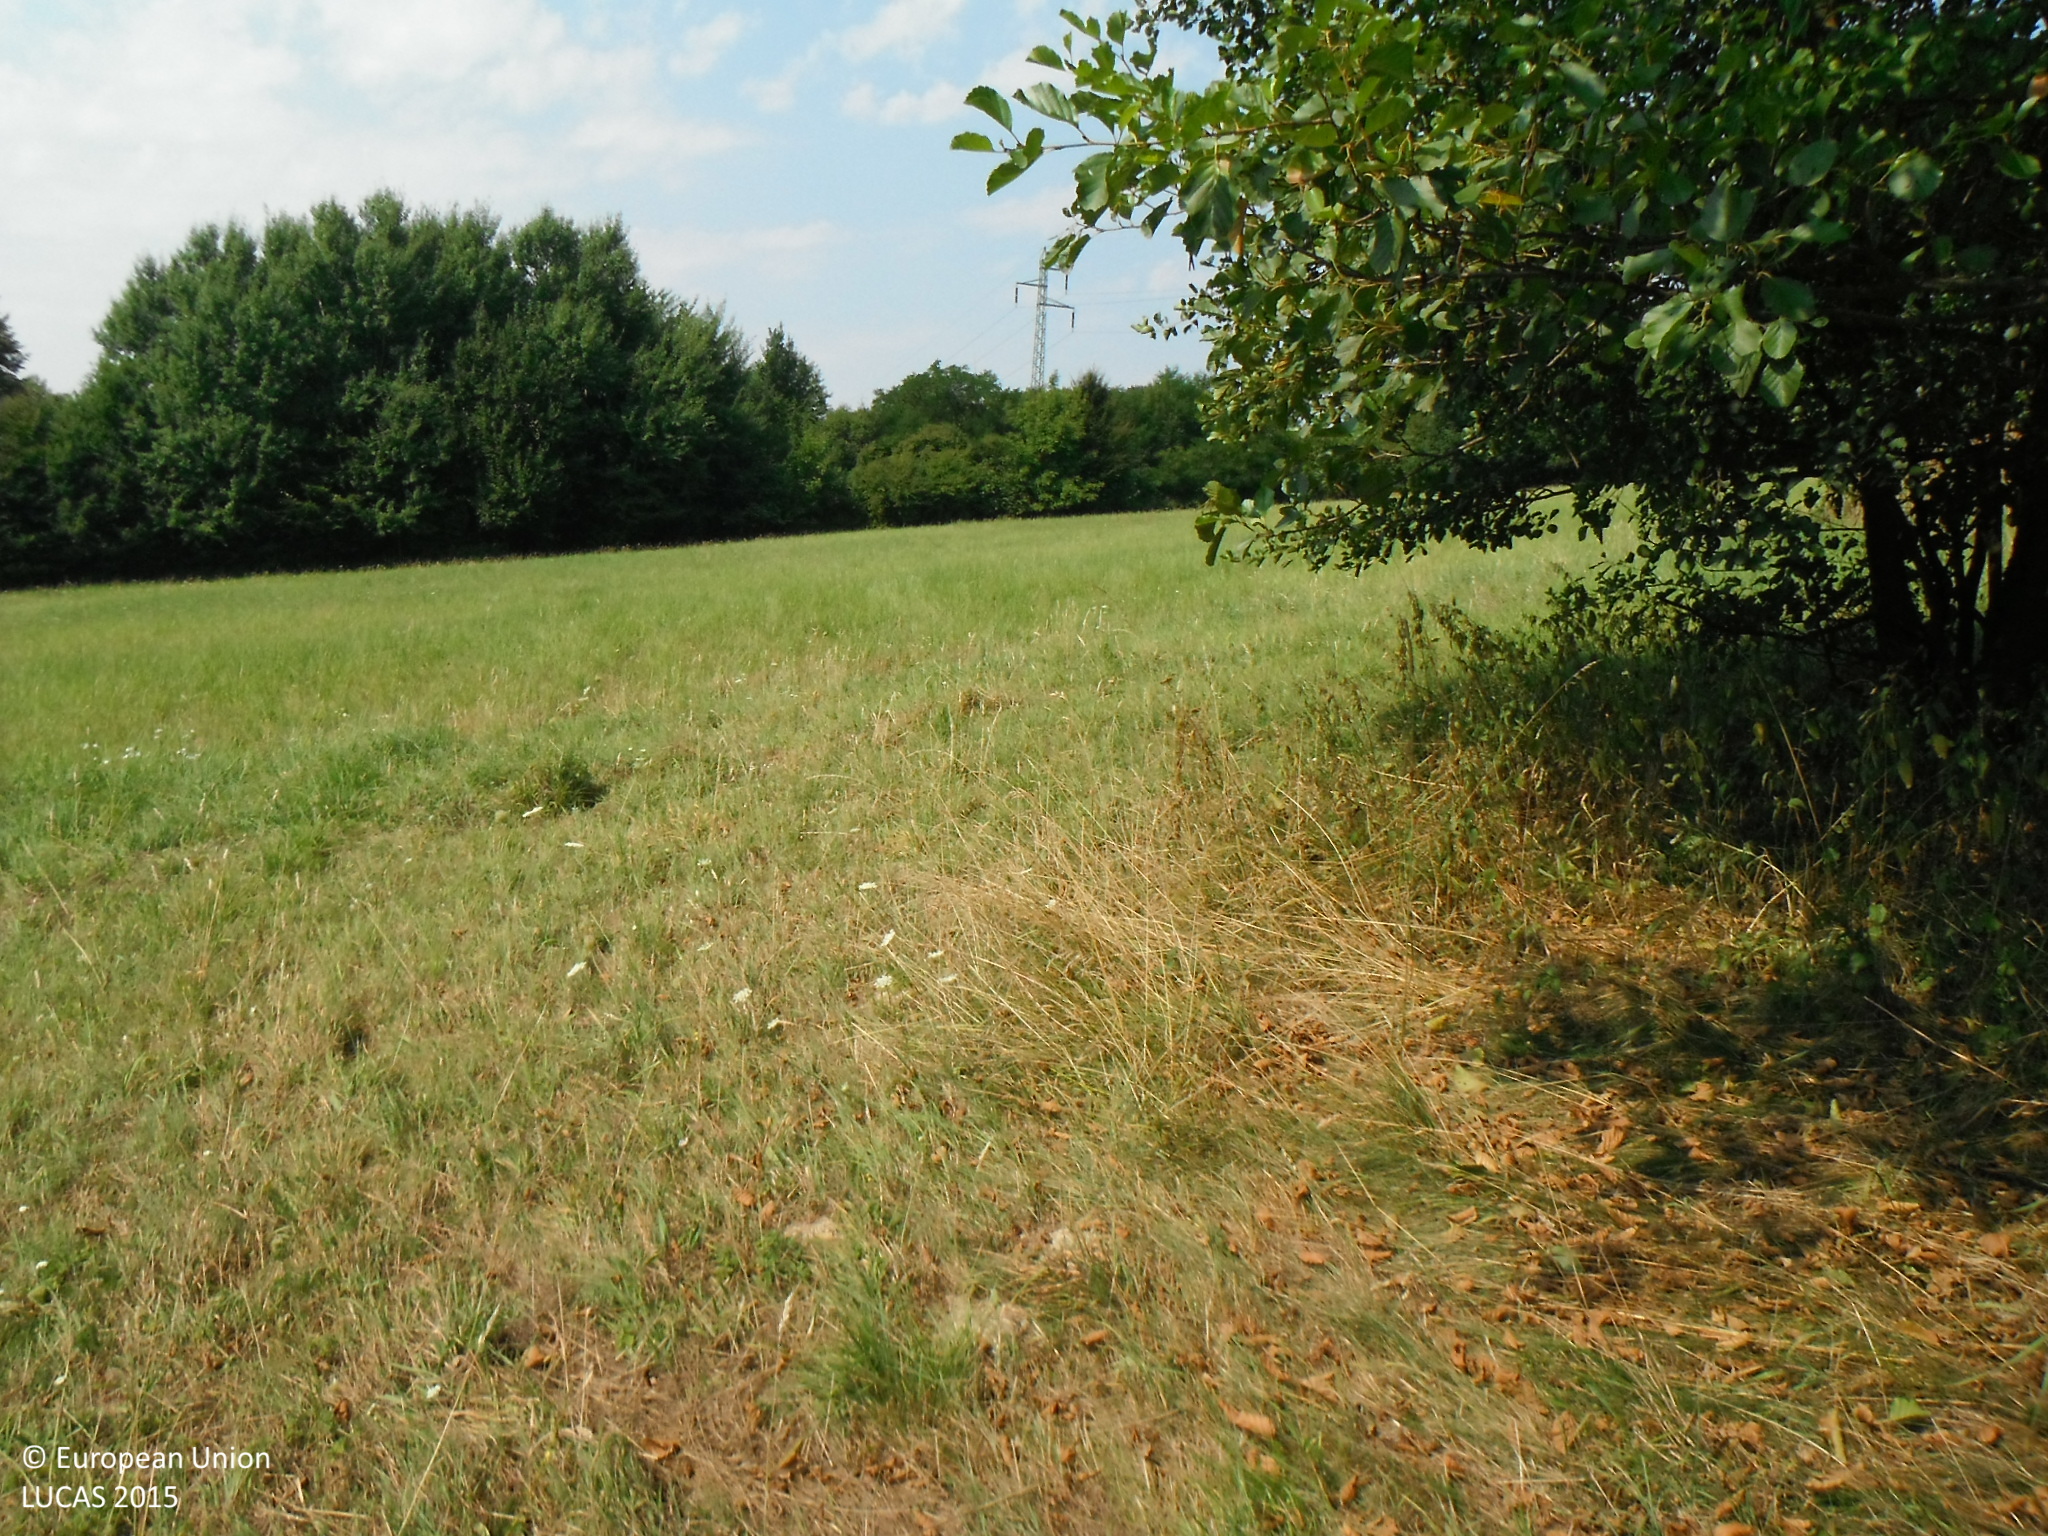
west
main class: Grassland
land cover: Grassland without tree/shrub cover
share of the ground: > 75 %
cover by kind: herbaceous plants 100 %
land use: Agriculture (excluding fallow land and kitchen gardens)
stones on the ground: < 10 %
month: August
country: SK
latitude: 49.0796
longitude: 18.3821
